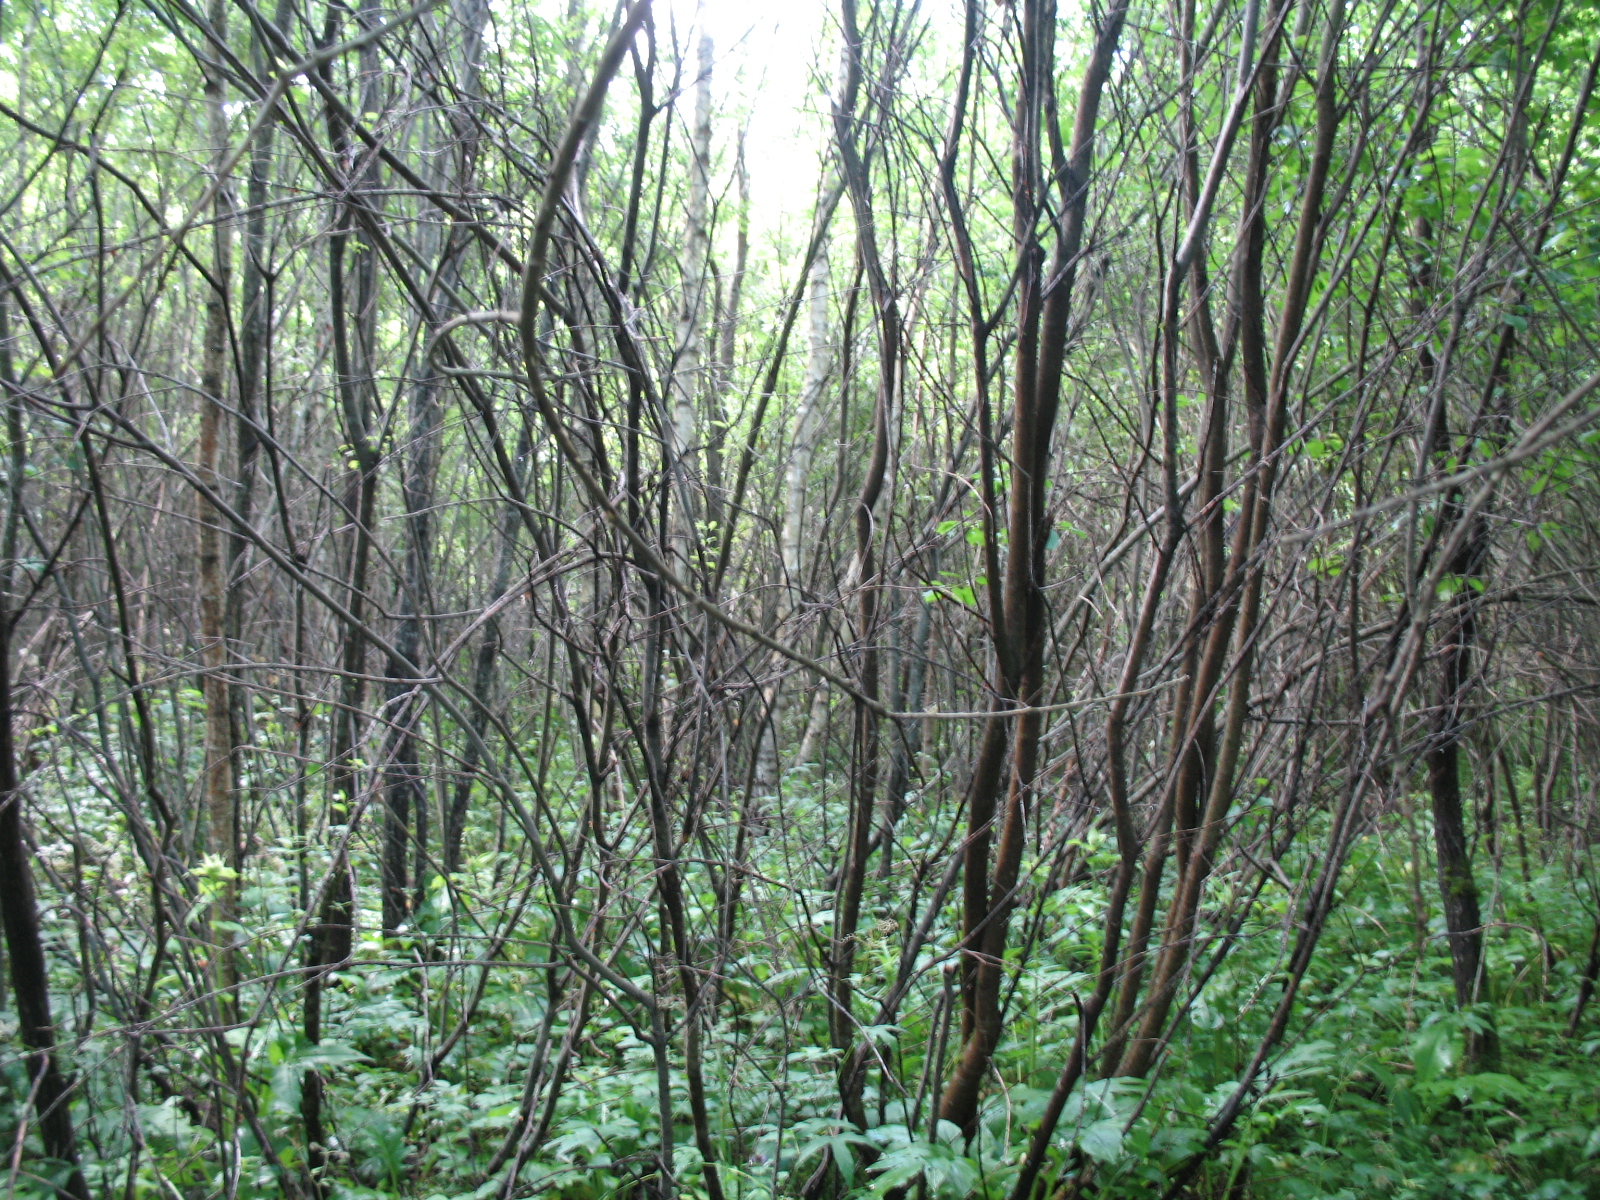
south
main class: Woodland
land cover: Broadleaved woodland
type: non-riverine alder, birch or aspen forest
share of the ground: > 75 %
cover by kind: broadleaved forest trees 90 %, shrubs 5 %, herbaceous plants 5 %
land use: Forestry
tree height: > 5 m
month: July
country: LV
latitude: 56.6052
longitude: 25.1135
